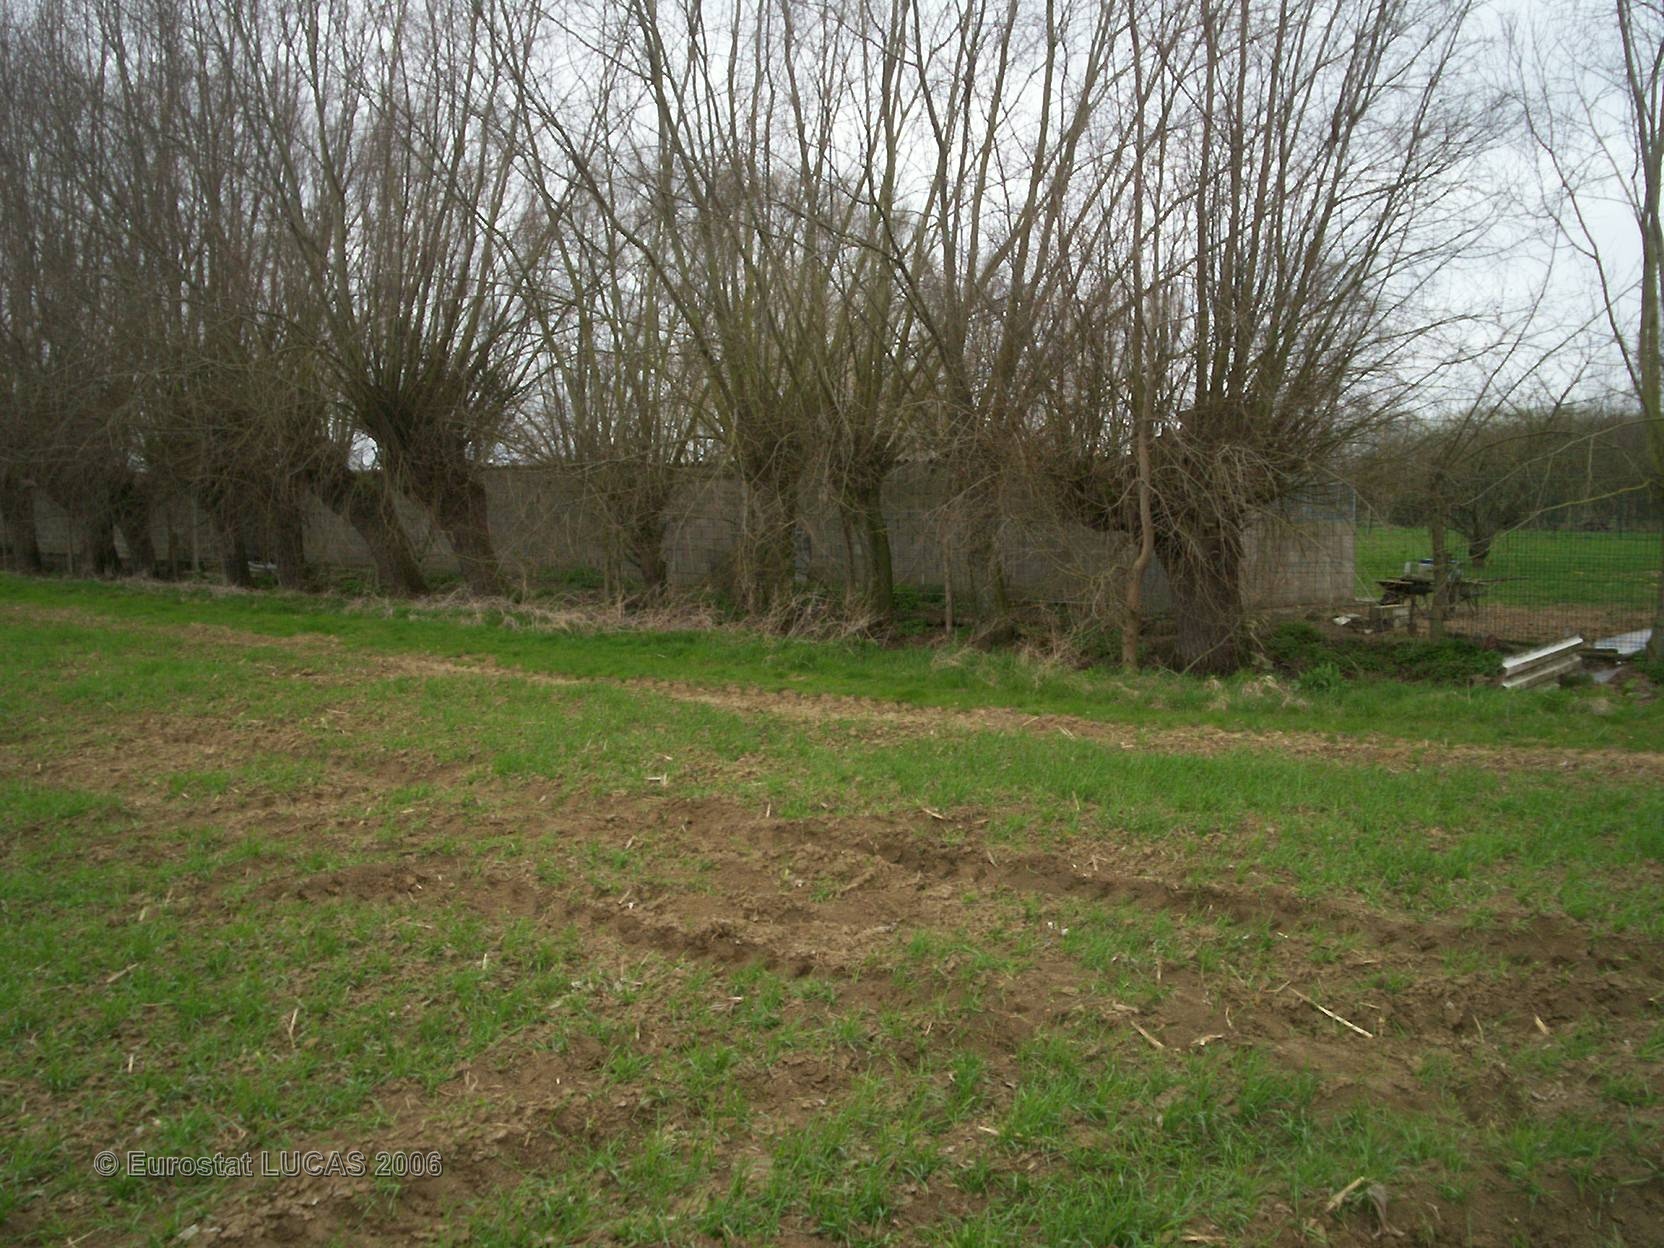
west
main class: Cropland
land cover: Common wheat
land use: Agriculture (excluding fallow land and kitchen gardens)
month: April
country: FR
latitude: 50.6061
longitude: 2.5126
